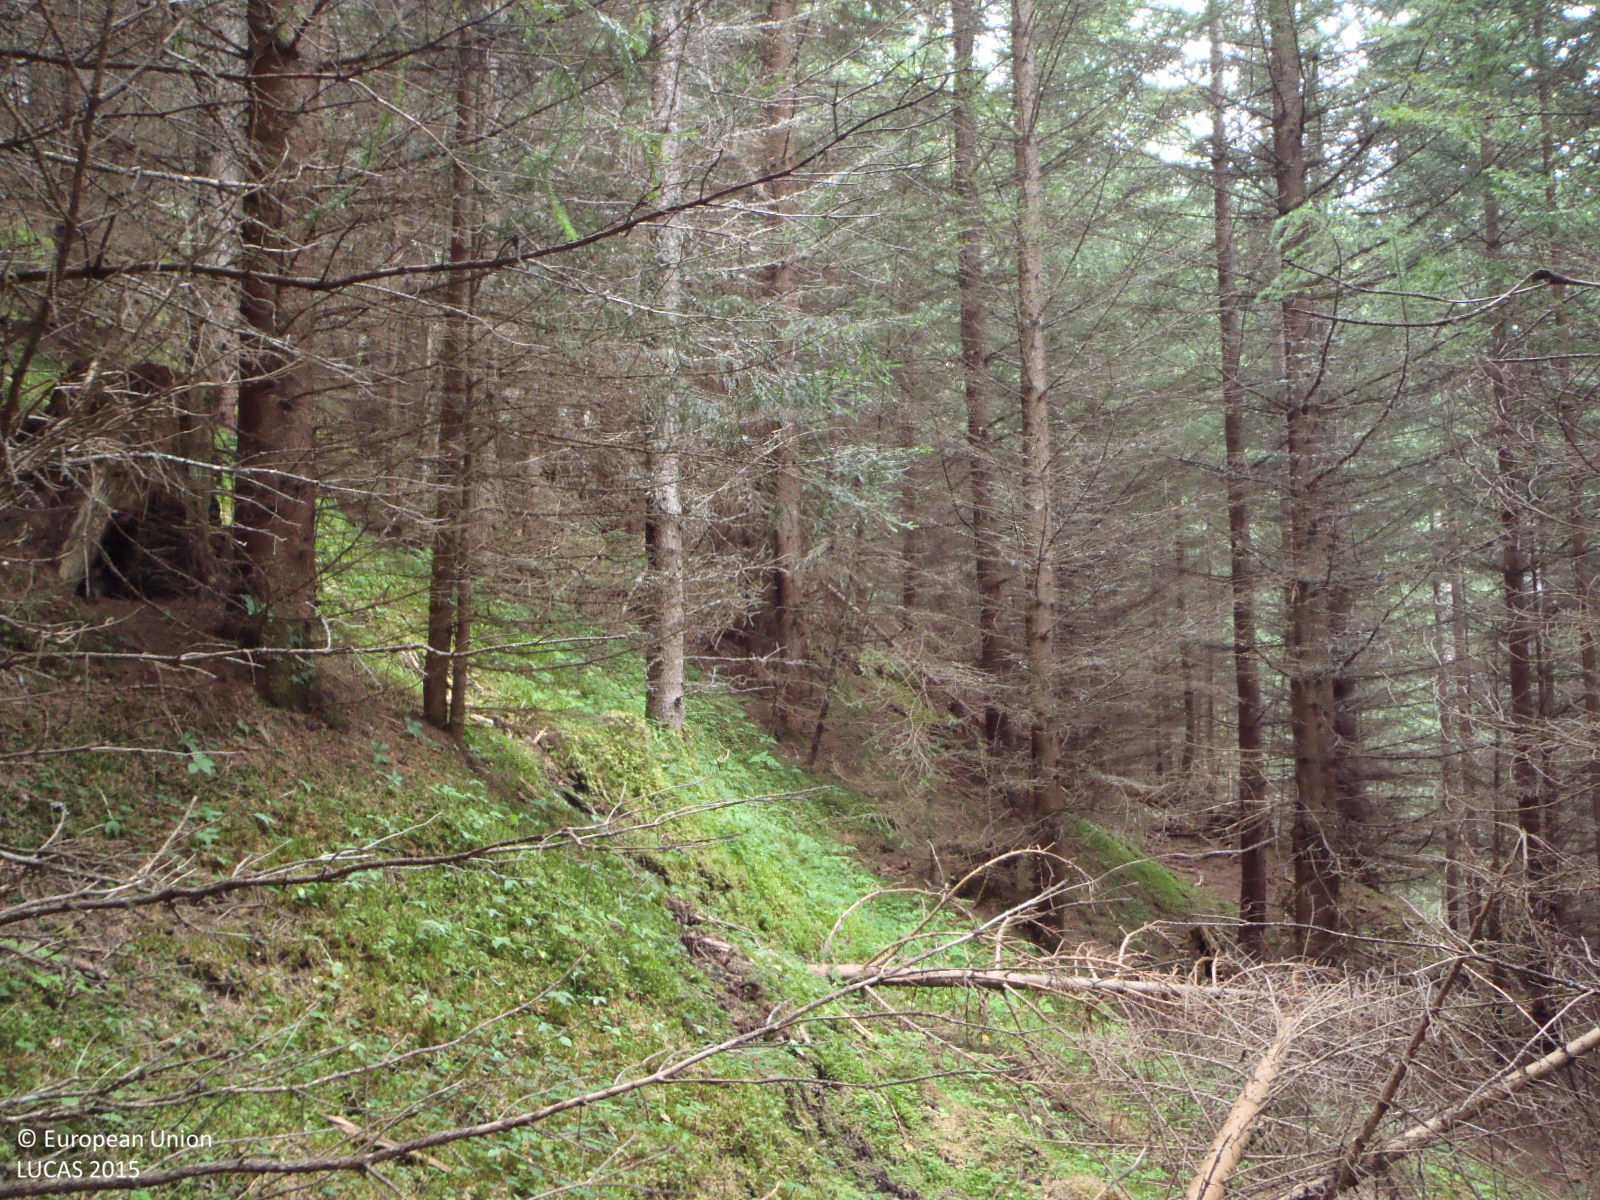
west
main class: Woodland
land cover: Spruce dominated coniferous woodland
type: alpine coniferous forest
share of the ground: > 75 %
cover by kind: coniferous forest trees 85 %, lichens and mosses 15 %
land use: Forestry
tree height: > 5 m
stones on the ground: < 10 %
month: August
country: AT
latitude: 47.1405
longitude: 13.5185
